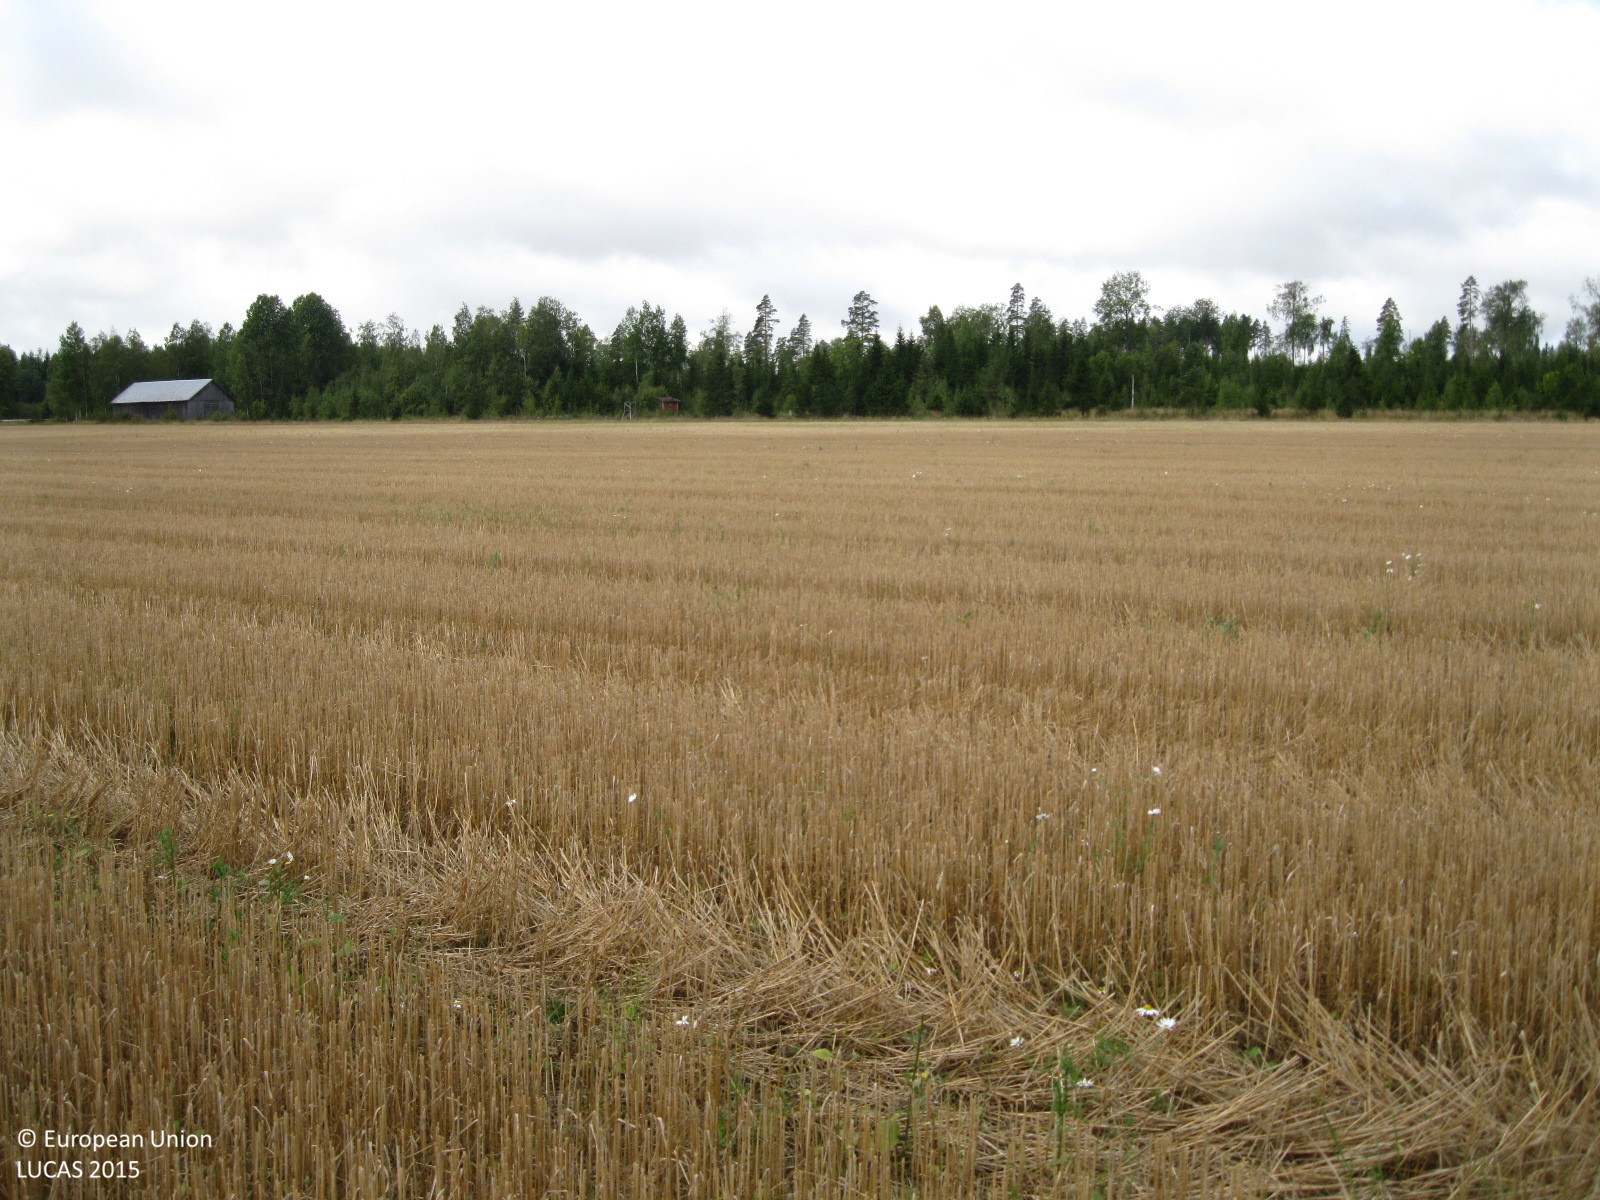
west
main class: Cropland
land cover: Common wheat
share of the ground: > 75 %
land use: Agriculture (excluding fallow land and kitchen gardens)
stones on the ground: < 10 %
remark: Harvested field
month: September
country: FI
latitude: 60.4353
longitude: 24.8498
